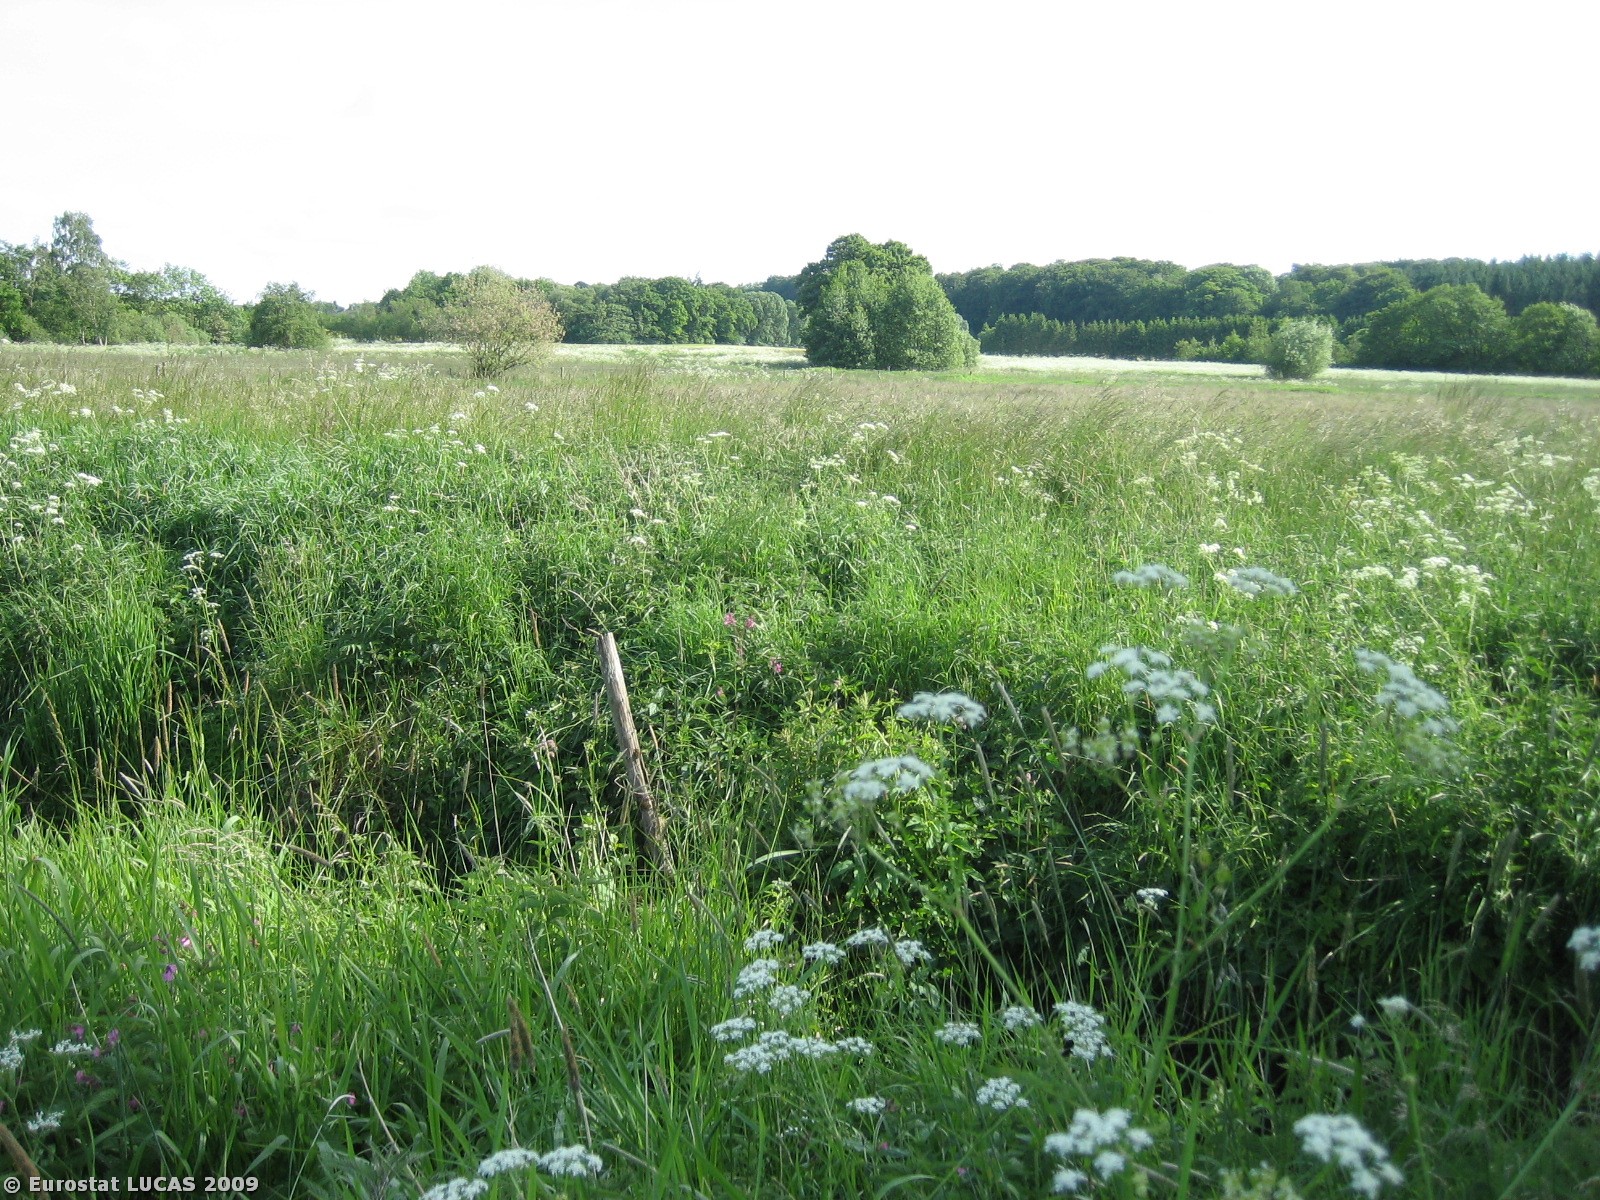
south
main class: Grassland
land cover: Grassland without tree/shrub cover
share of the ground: > 75 %
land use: Unused
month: June
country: DK
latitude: 56.1697
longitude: 9.8552
